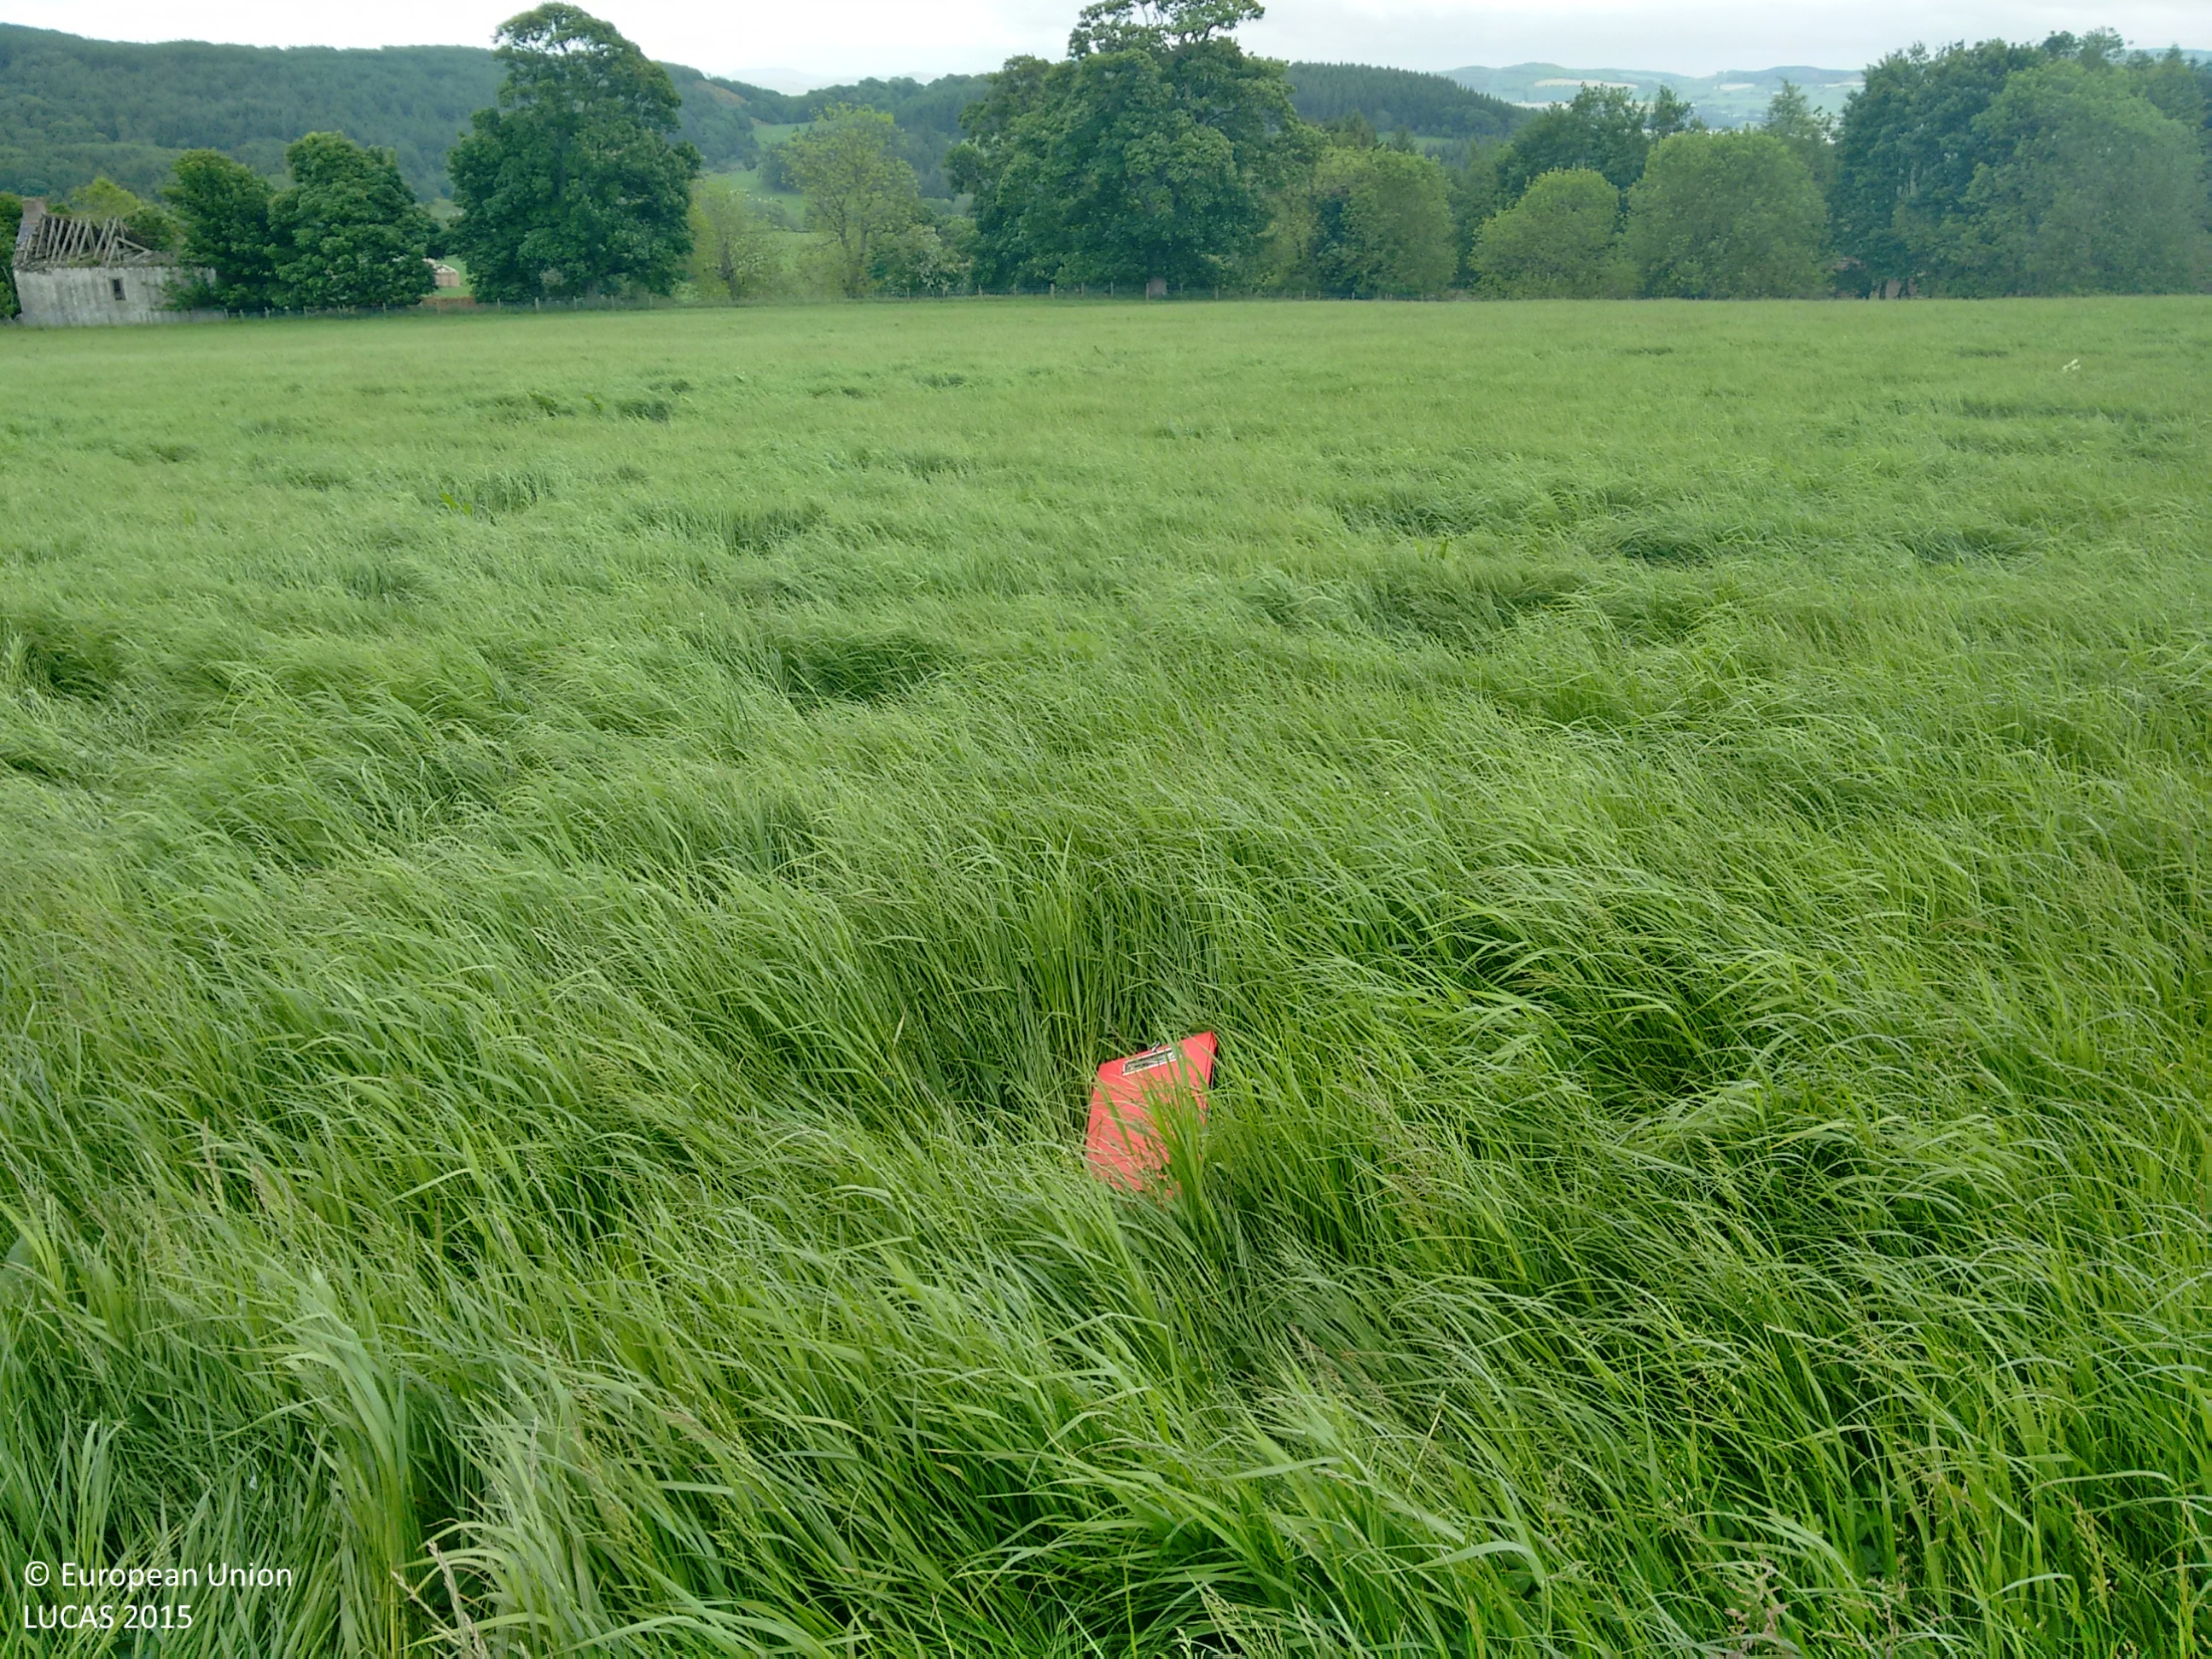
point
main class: Grassland
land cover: Grassland without tree/shrub cover
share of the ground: > 75 %
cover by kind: herbaceous plants 100 %
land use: Agriculture (excluding fallow land and kitchen gardens)
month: June
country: GB
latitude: 56.3996
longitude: -3.3423
